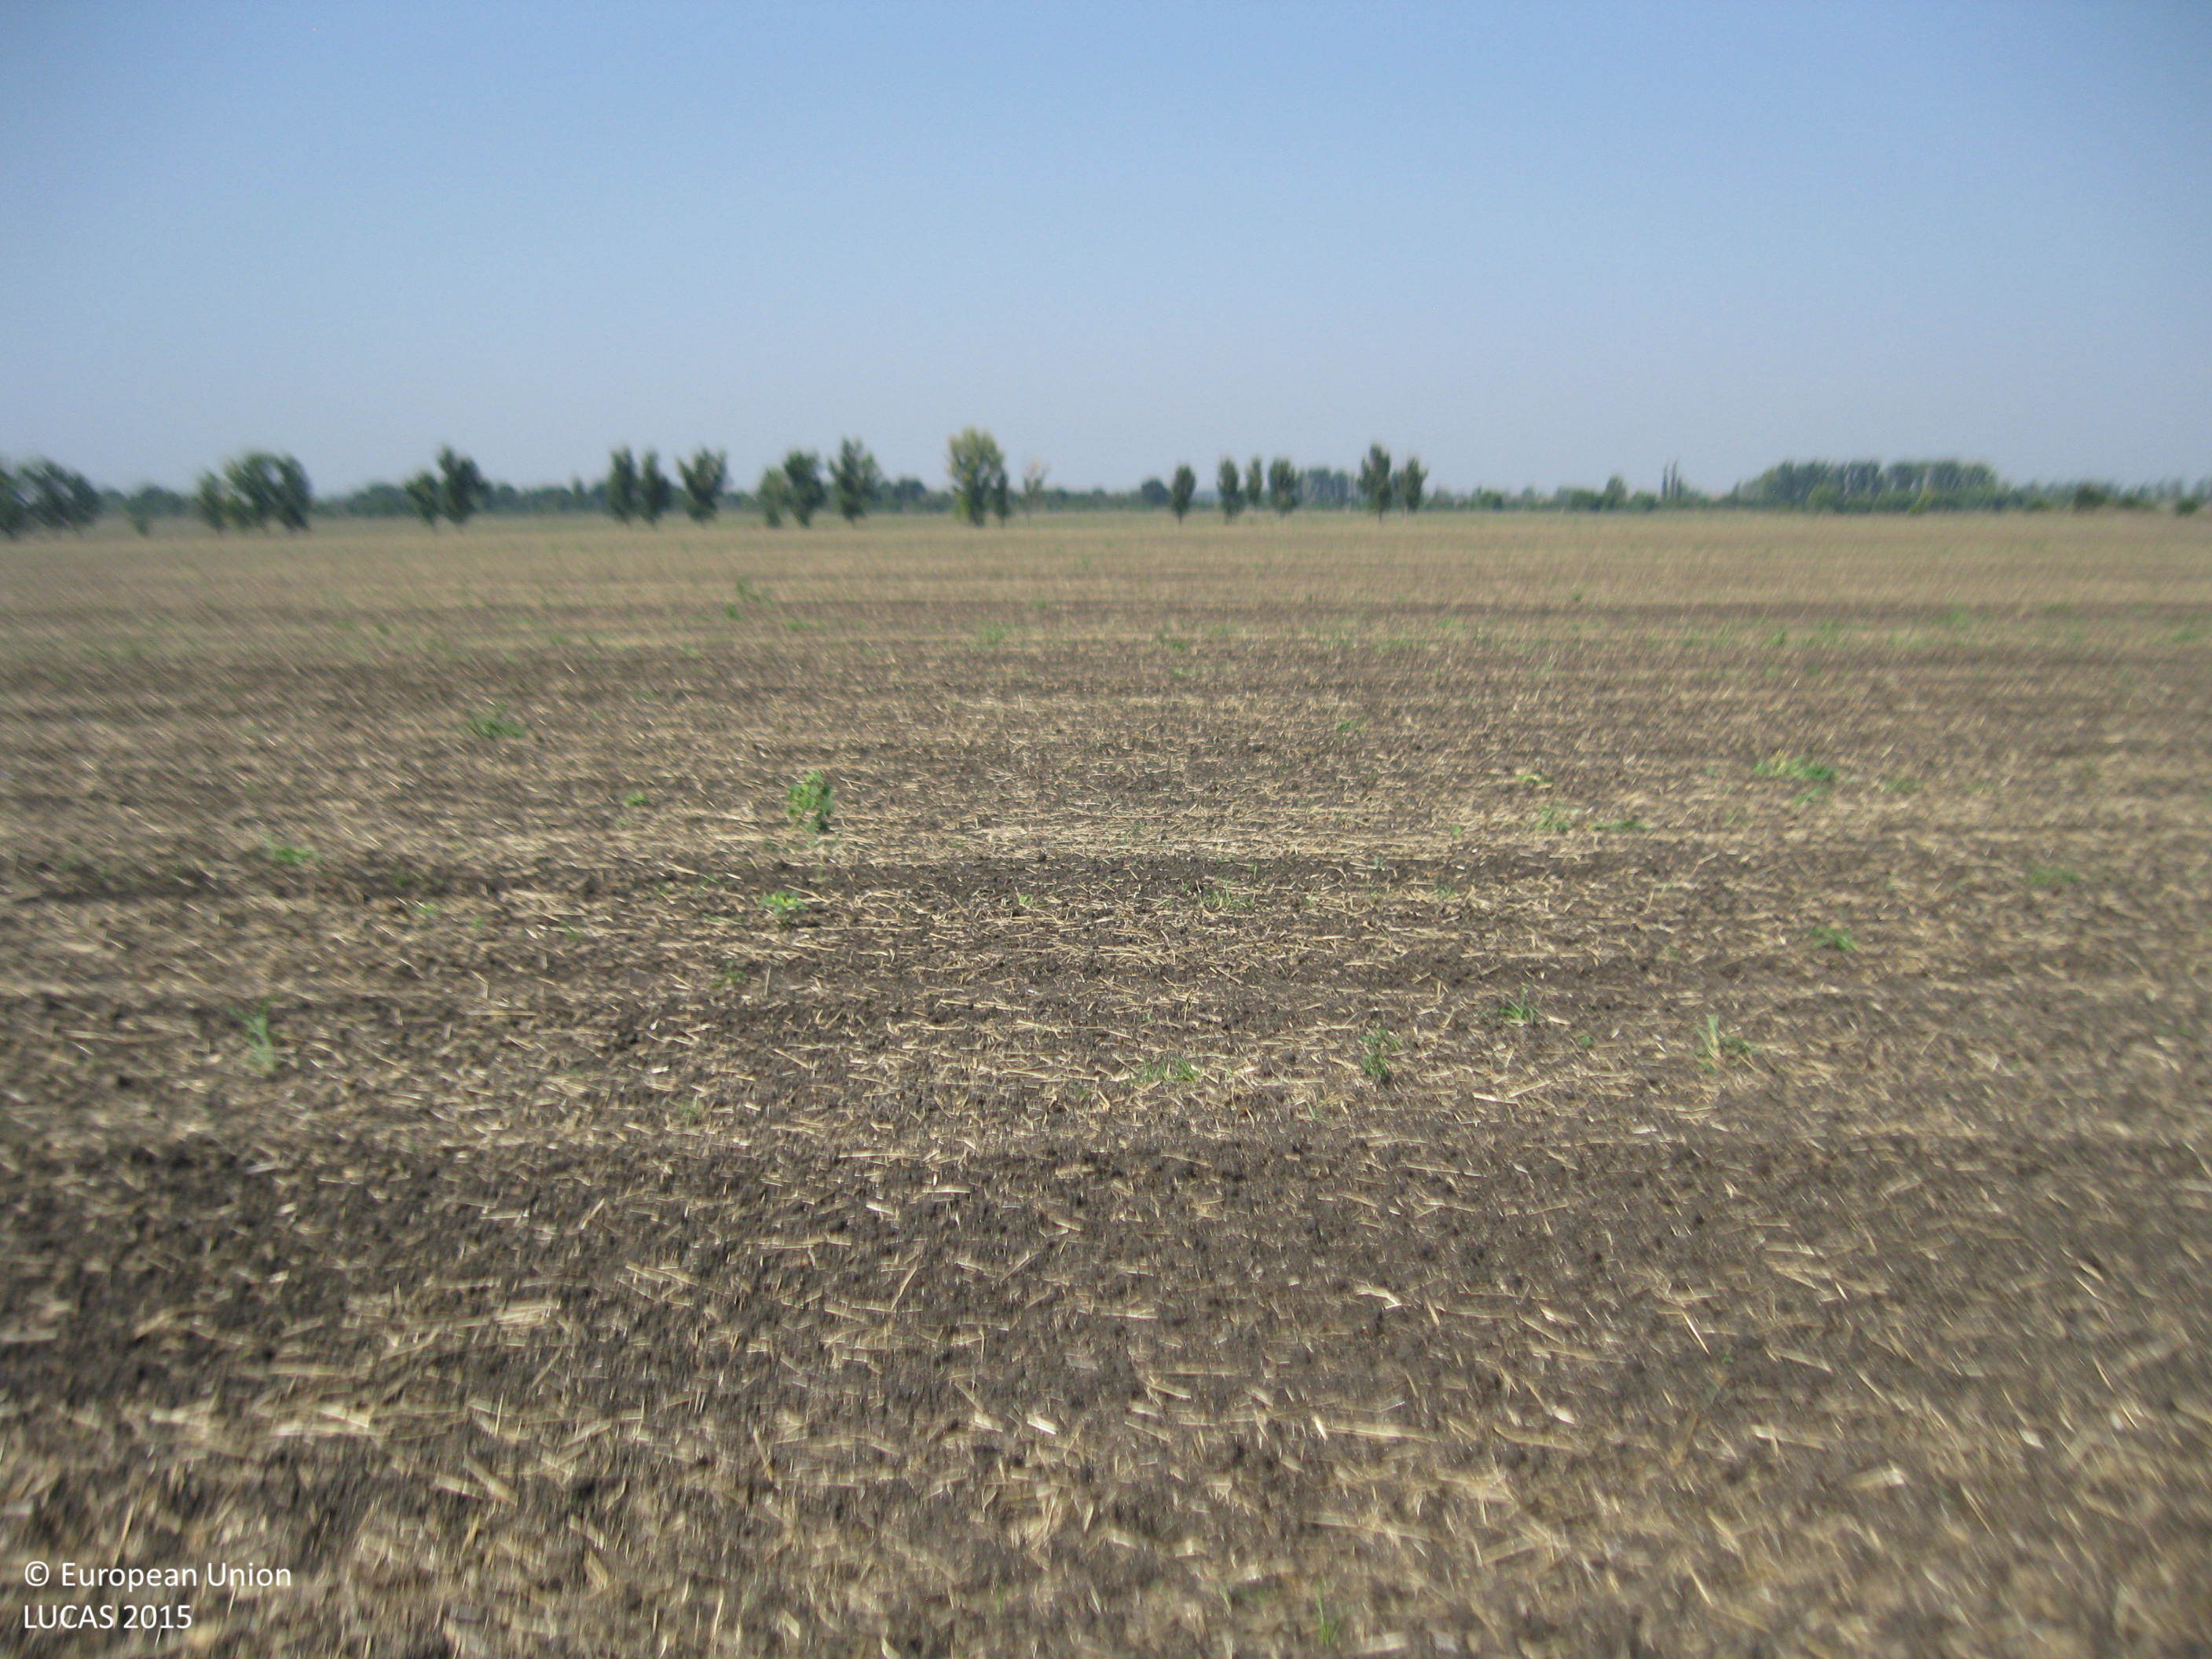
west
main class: Cropland
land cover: Common wheat
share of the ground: < 10 %
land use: Agriculture (excluding fallow land and kitchen gardens)
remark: Harvested field
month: September
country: BG
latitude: 42.2765
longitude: 25.0331
